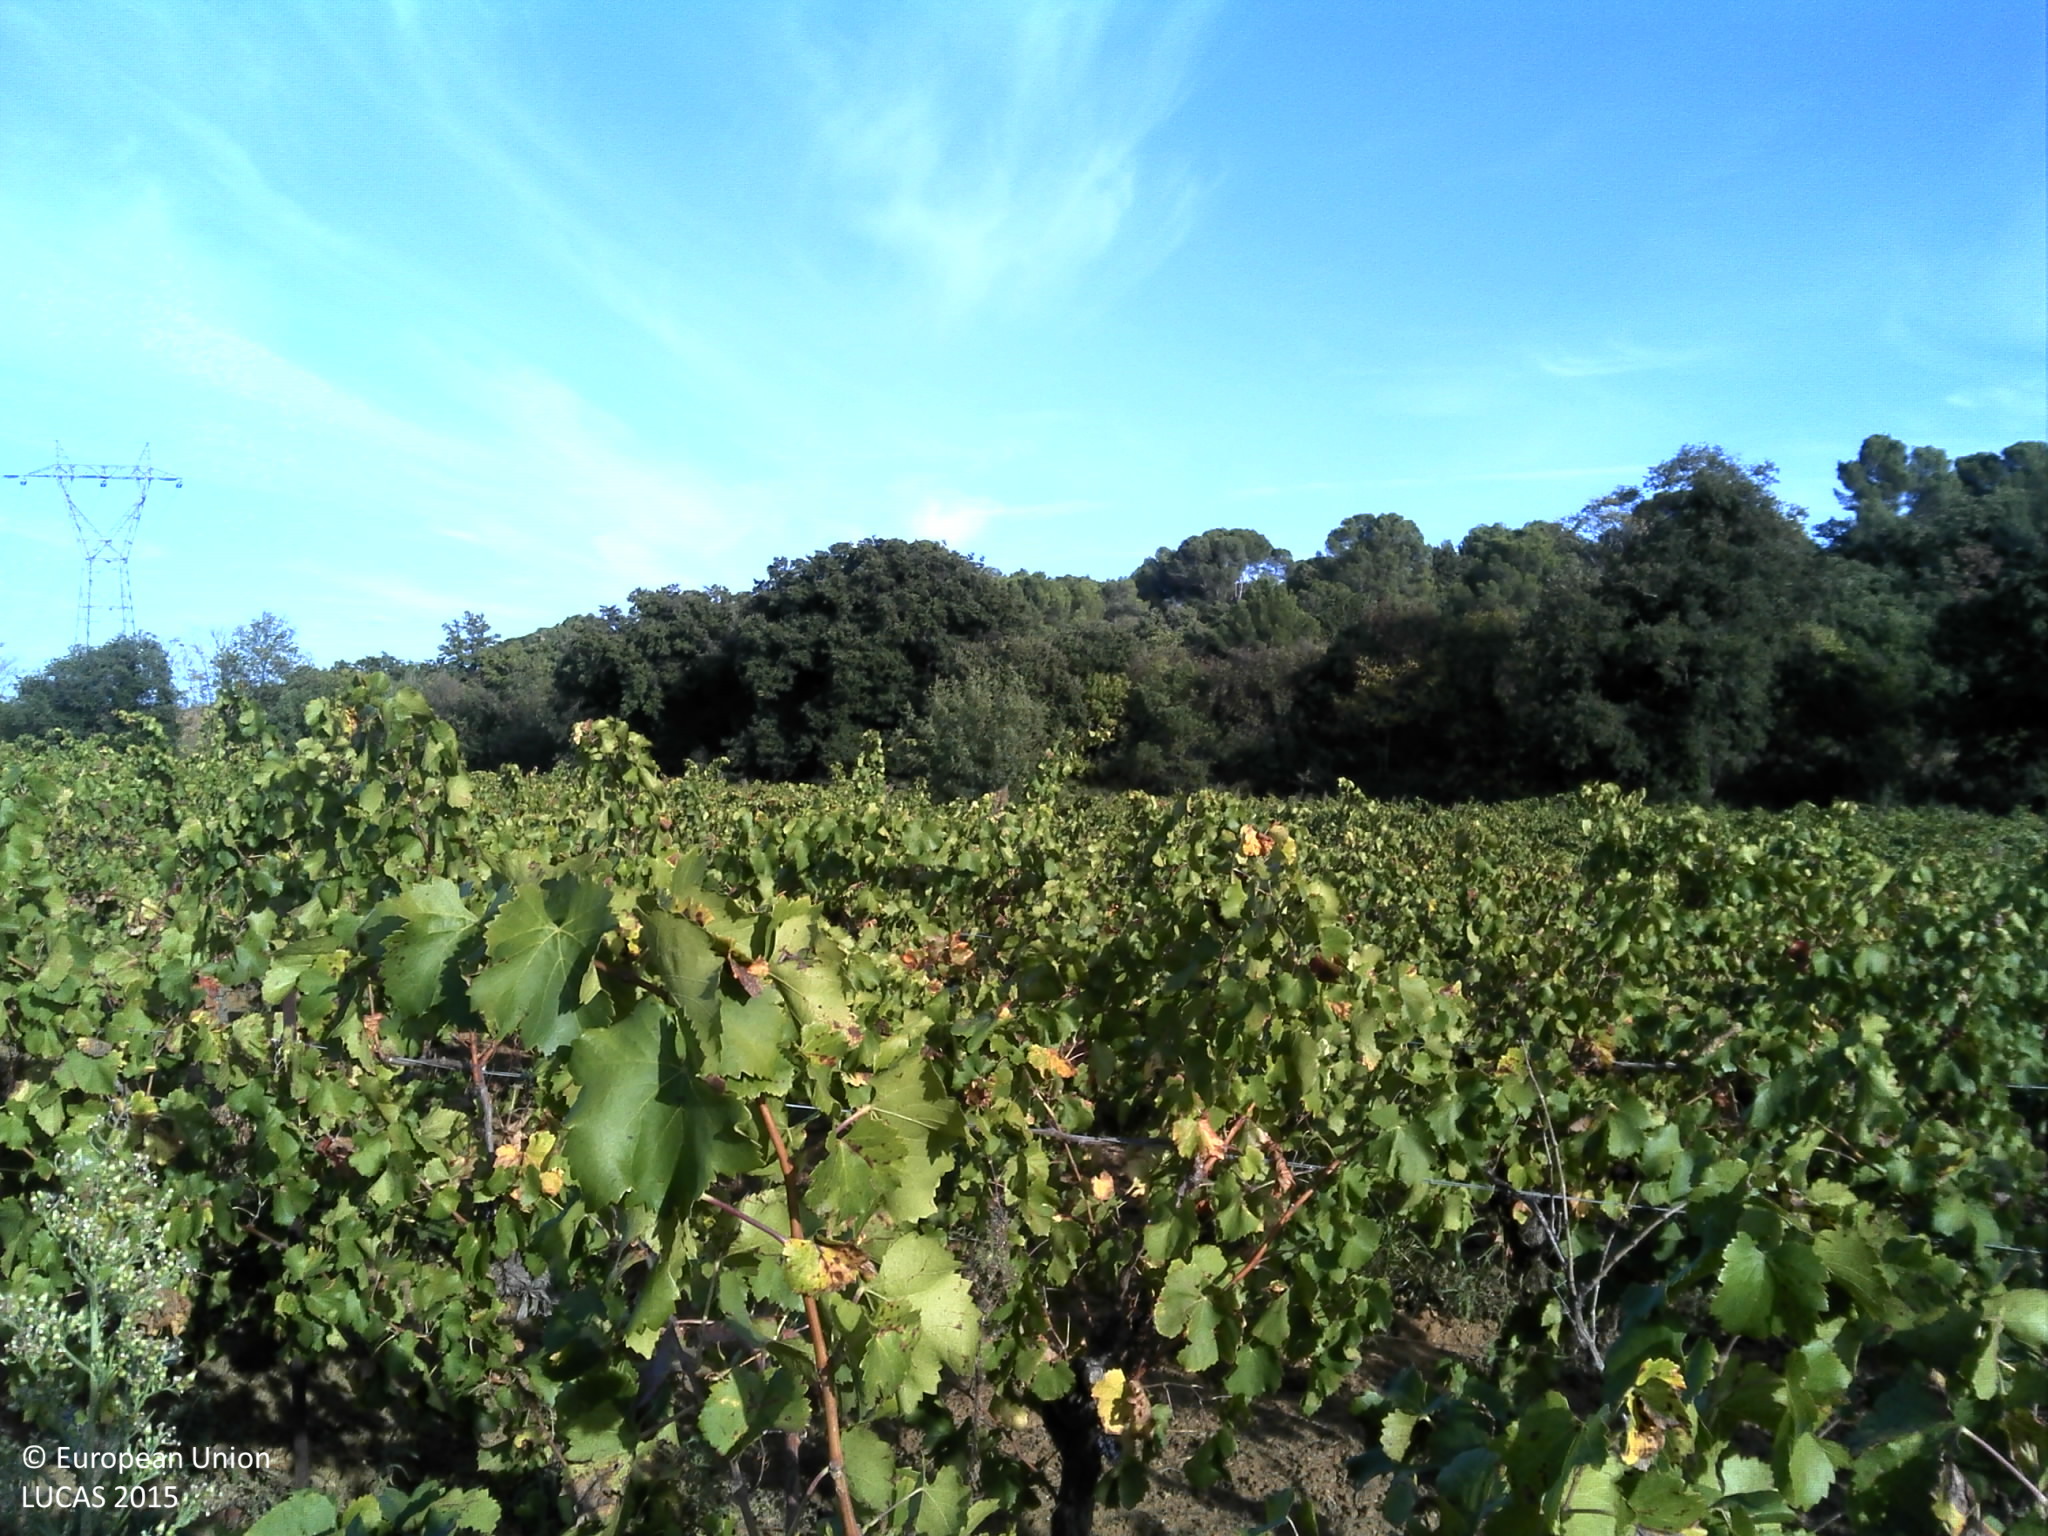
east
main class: Cropland
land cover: Vineyards
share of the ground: 10 - 25 %
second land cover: Other bare soil
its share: > 75 %
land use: Agriculture (excluding fallow land and kitchen gardens)
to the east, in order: Vineyards; Other bare soil; Broadleaved woodland; Rivers and streams; Broadleaved woodland; Vineyards; Broadleaved woodland
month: October
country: FR
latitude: 43.3939
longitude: 3.3303
